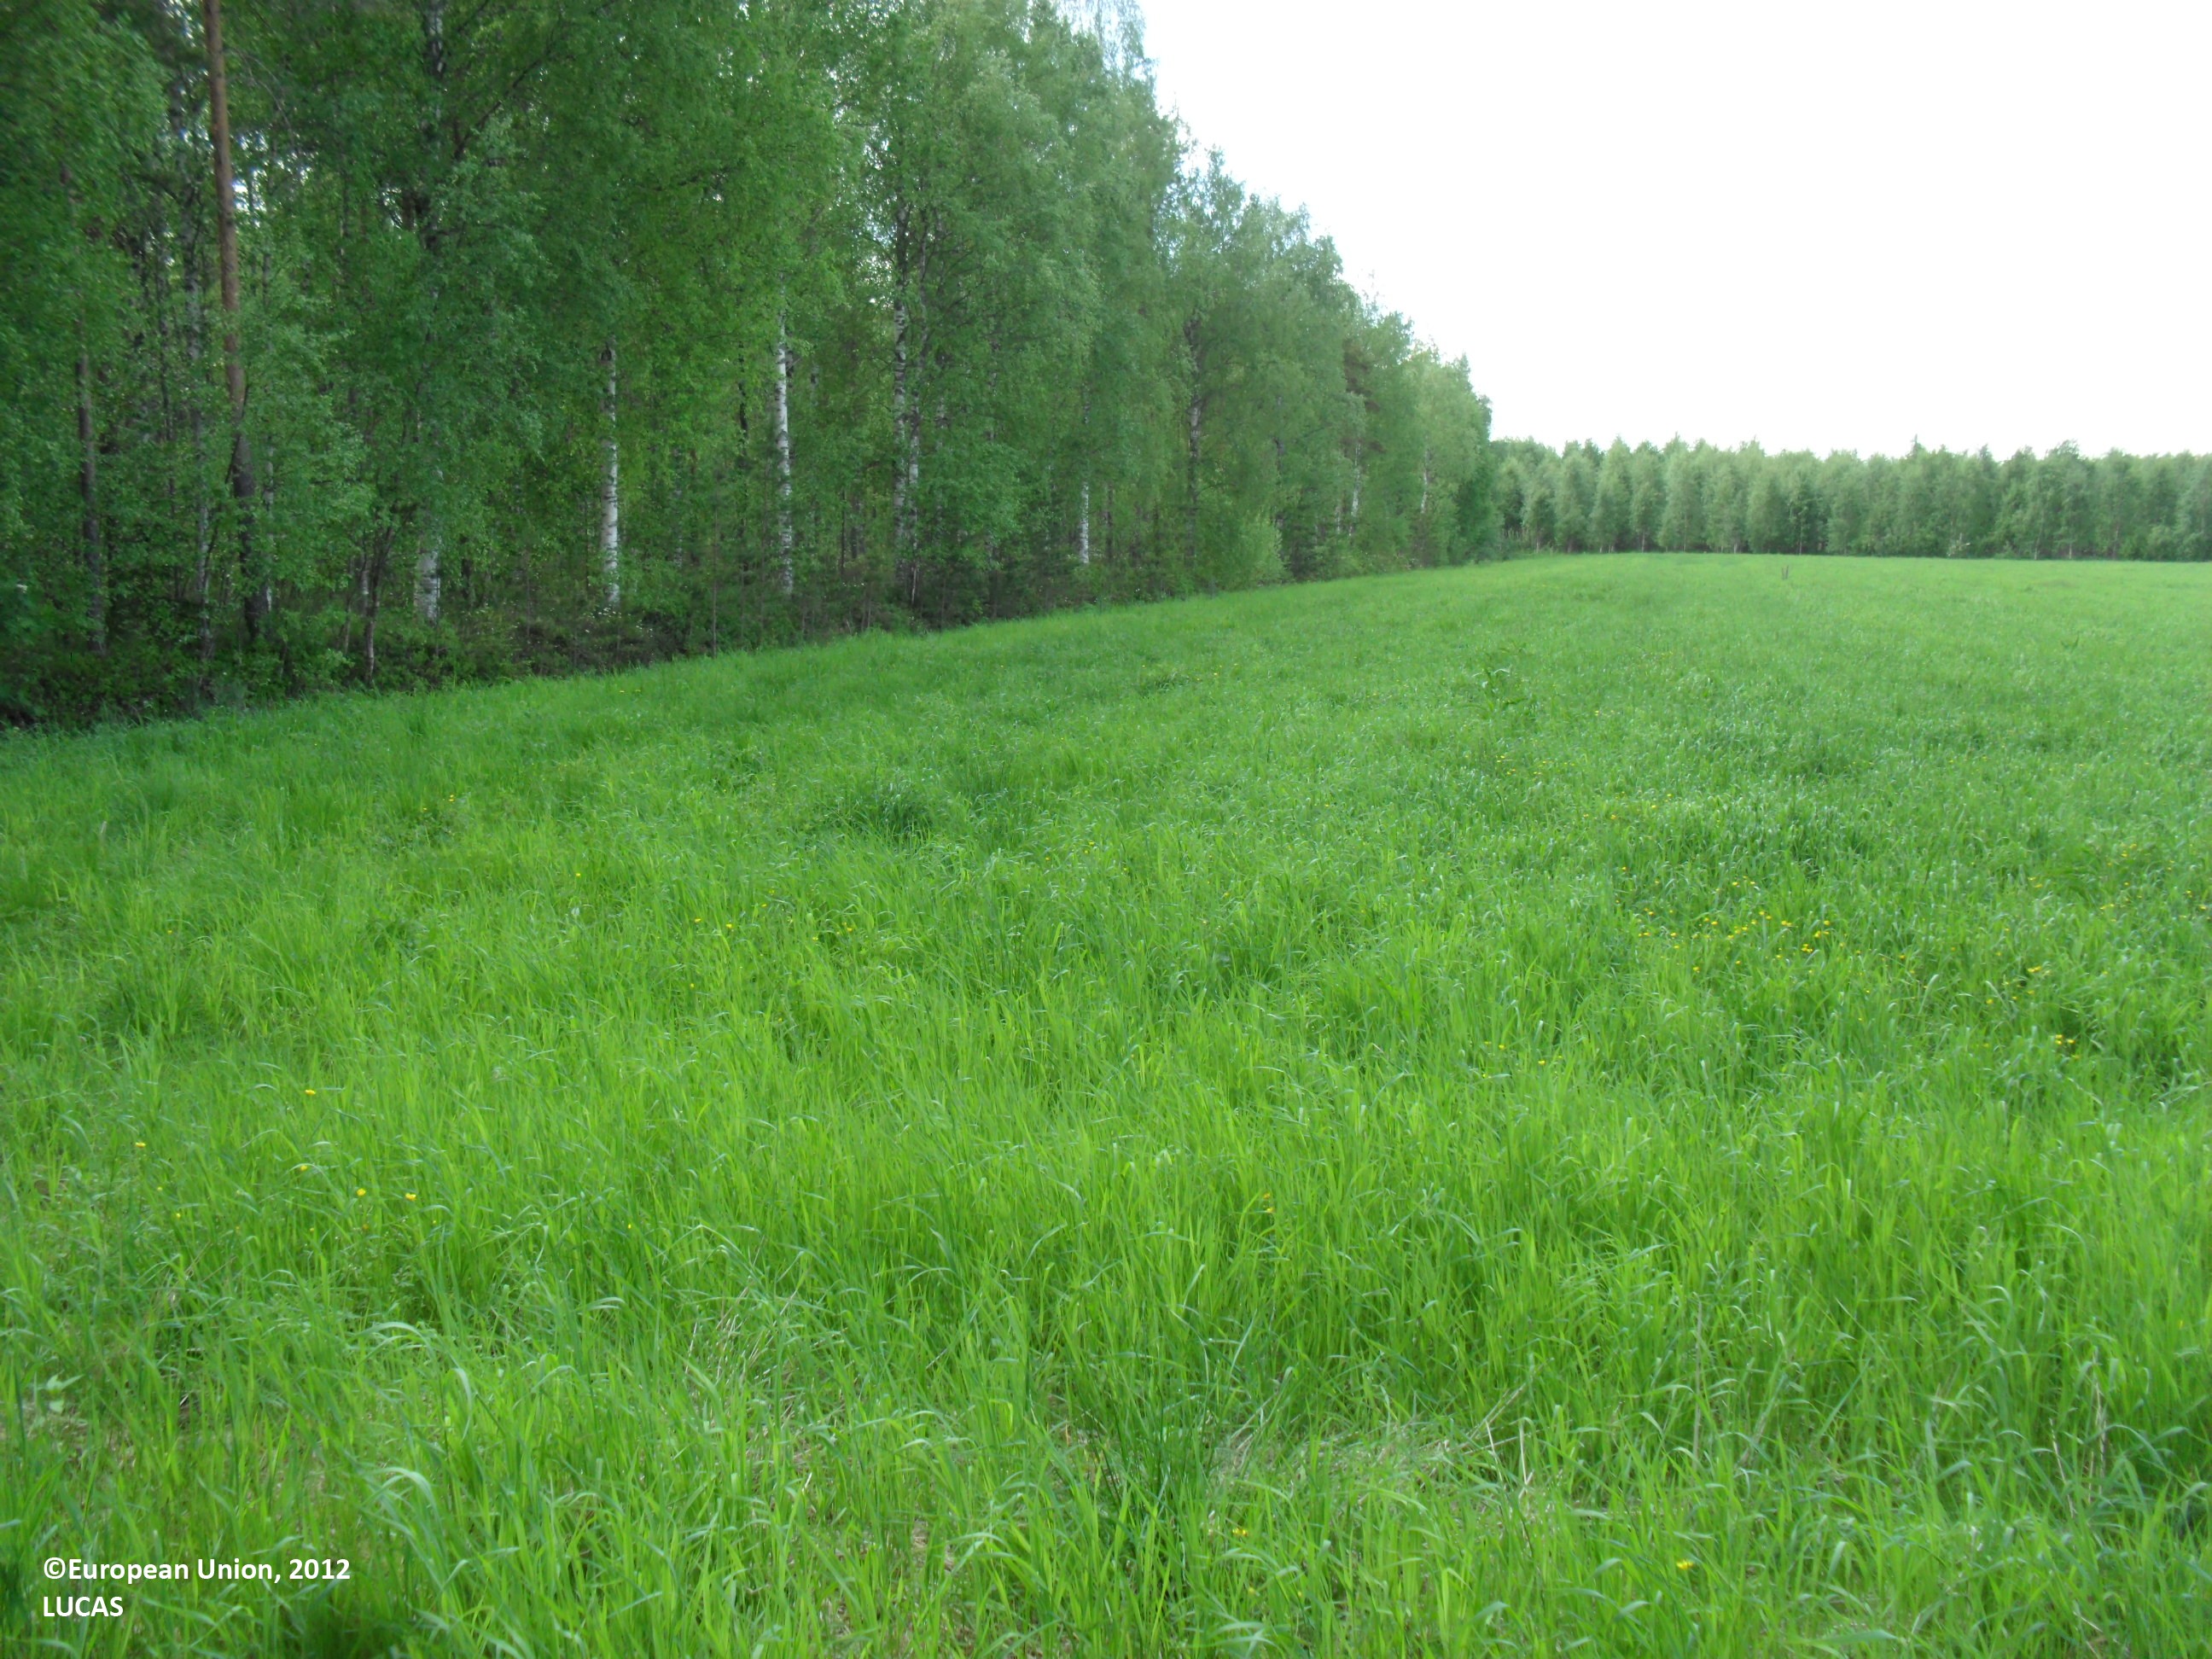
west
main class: Grassland
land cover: Grassland without tree/shrub cover
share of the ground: > 75 %
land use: Agriculture (excluding fallow land and kitchen gardens)
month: June
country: FI
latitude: 62.8218
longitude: 23.5509
